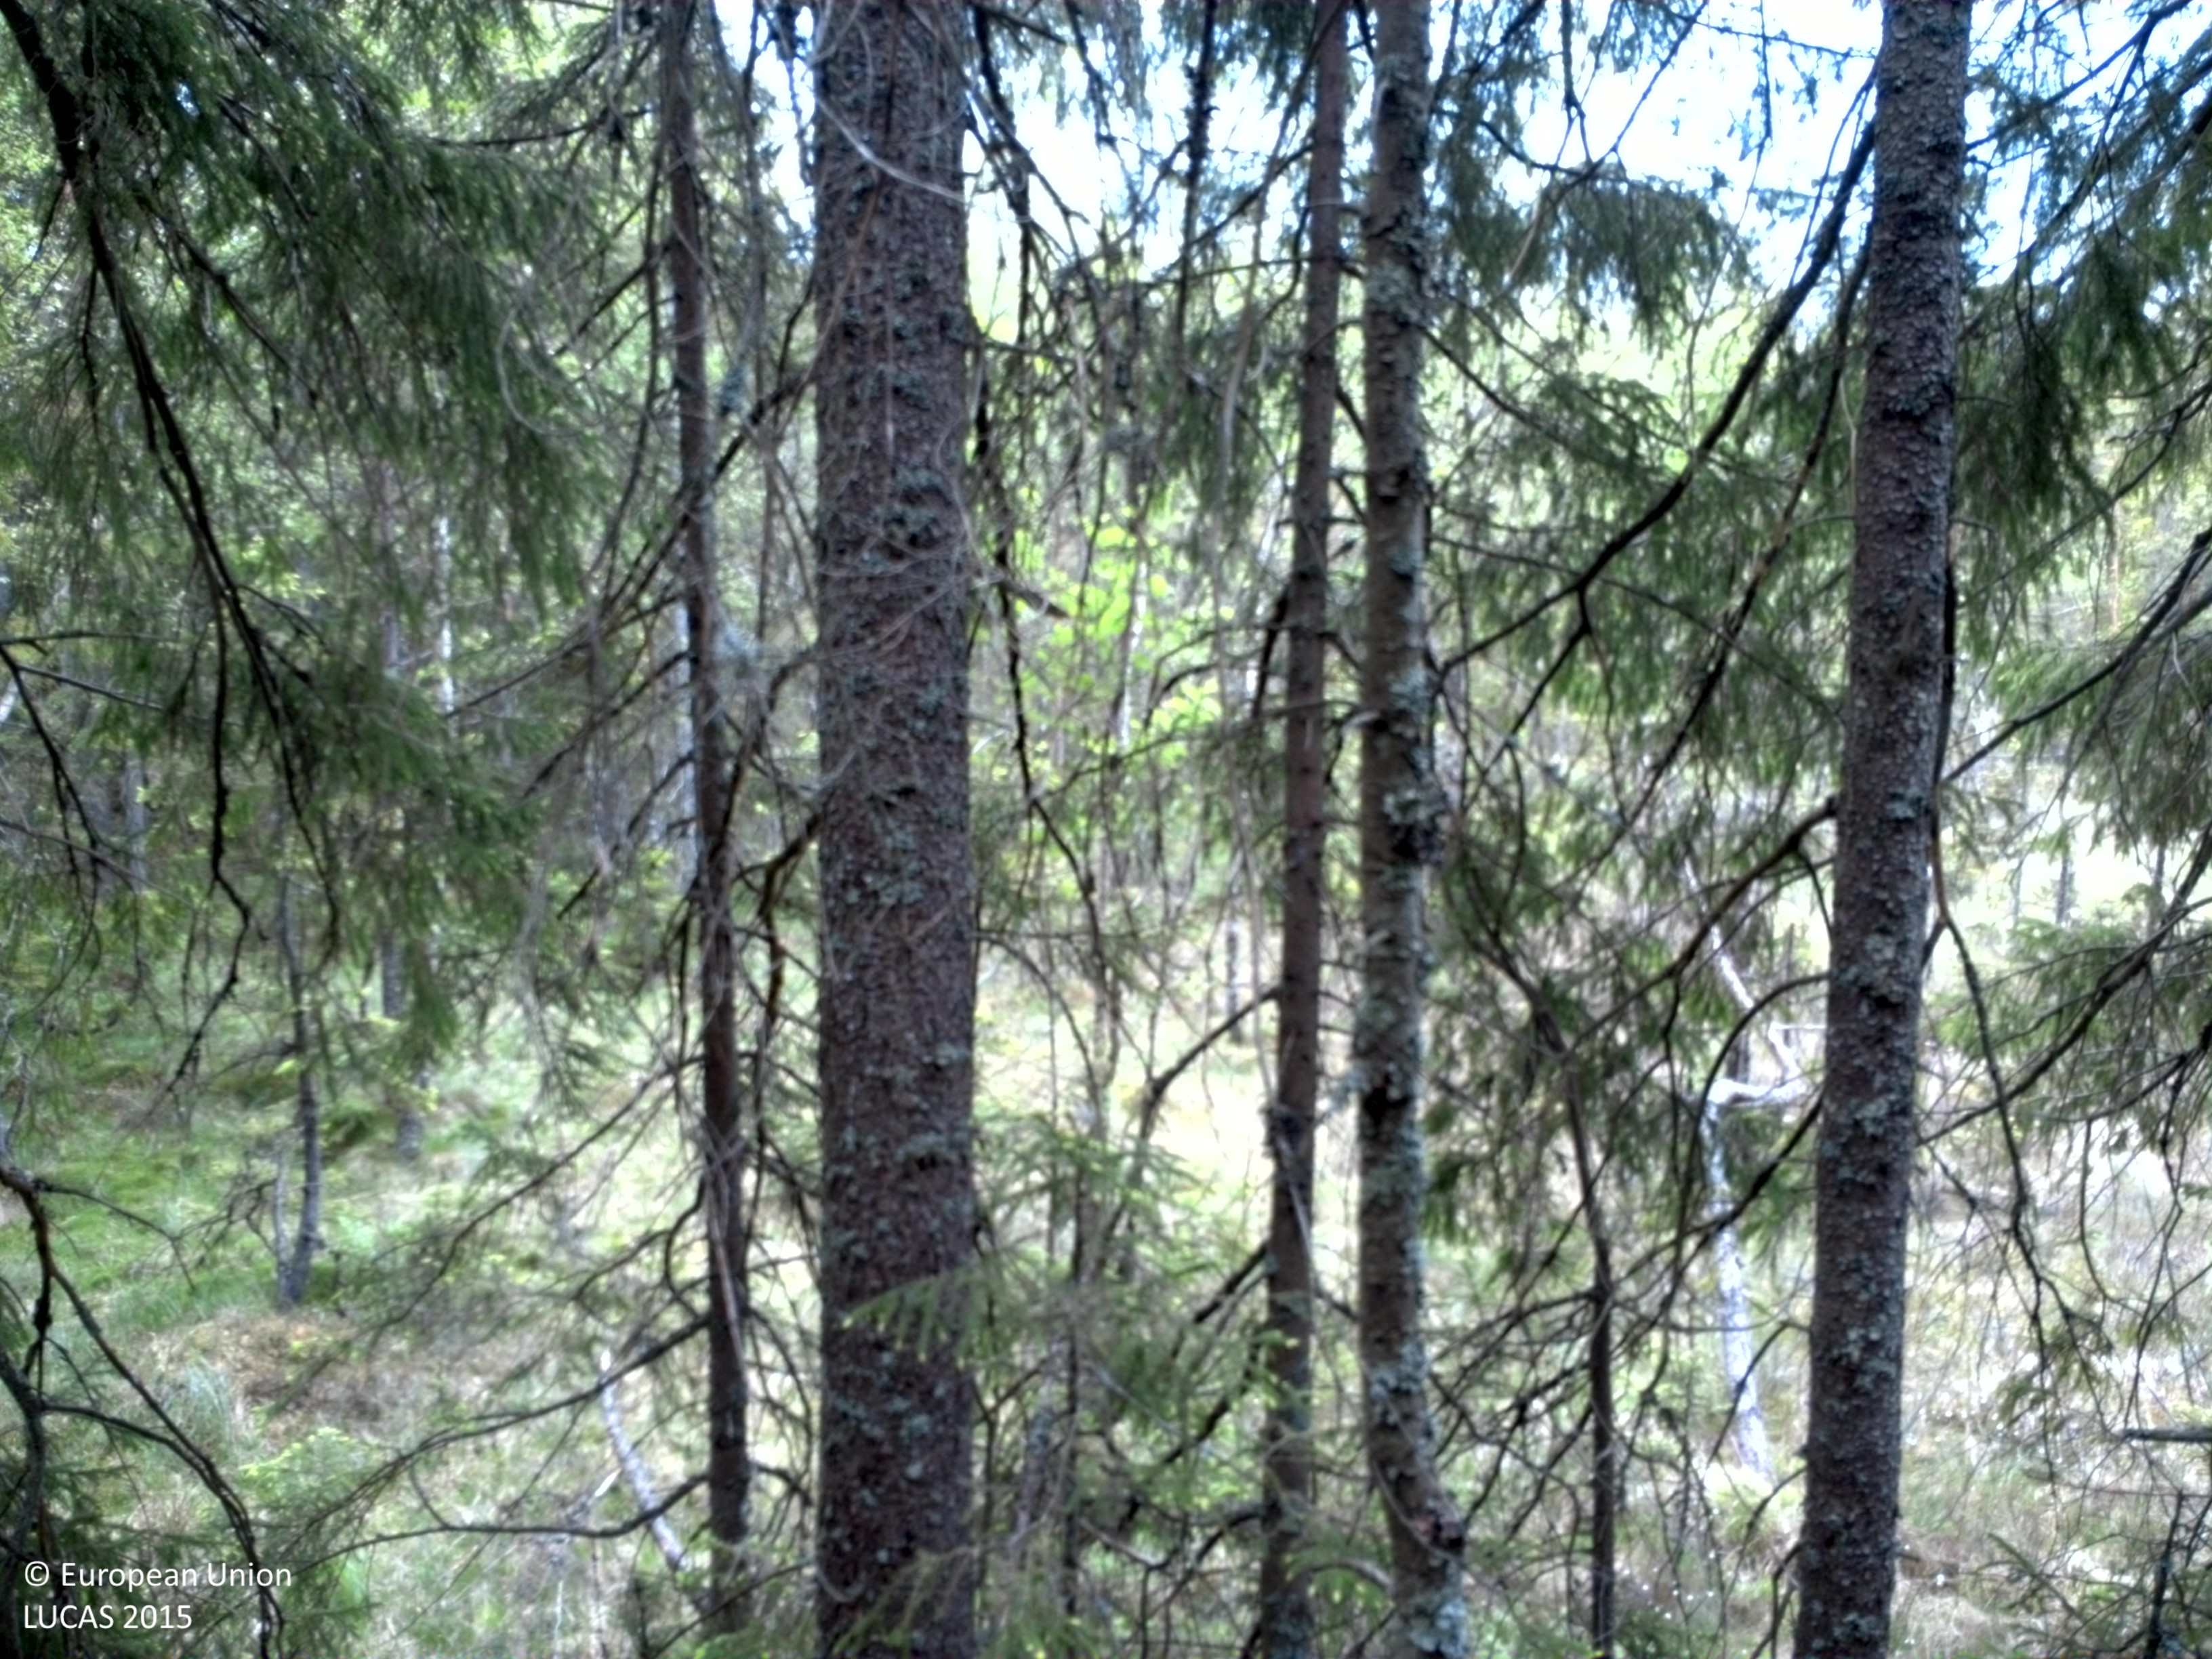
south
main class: Woodland
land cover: Spruce dominated coniferous woodland
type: boreal forest
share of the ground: 25 - 50 %
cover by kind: coniferous forest trees 45 %, shrubs 45 %, broadleaved forest trees 5 %, lichens and mosses 5 %
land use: Forestry
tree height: > 5 m
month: June
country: SE
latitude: 57.4982
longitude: 13.8500
